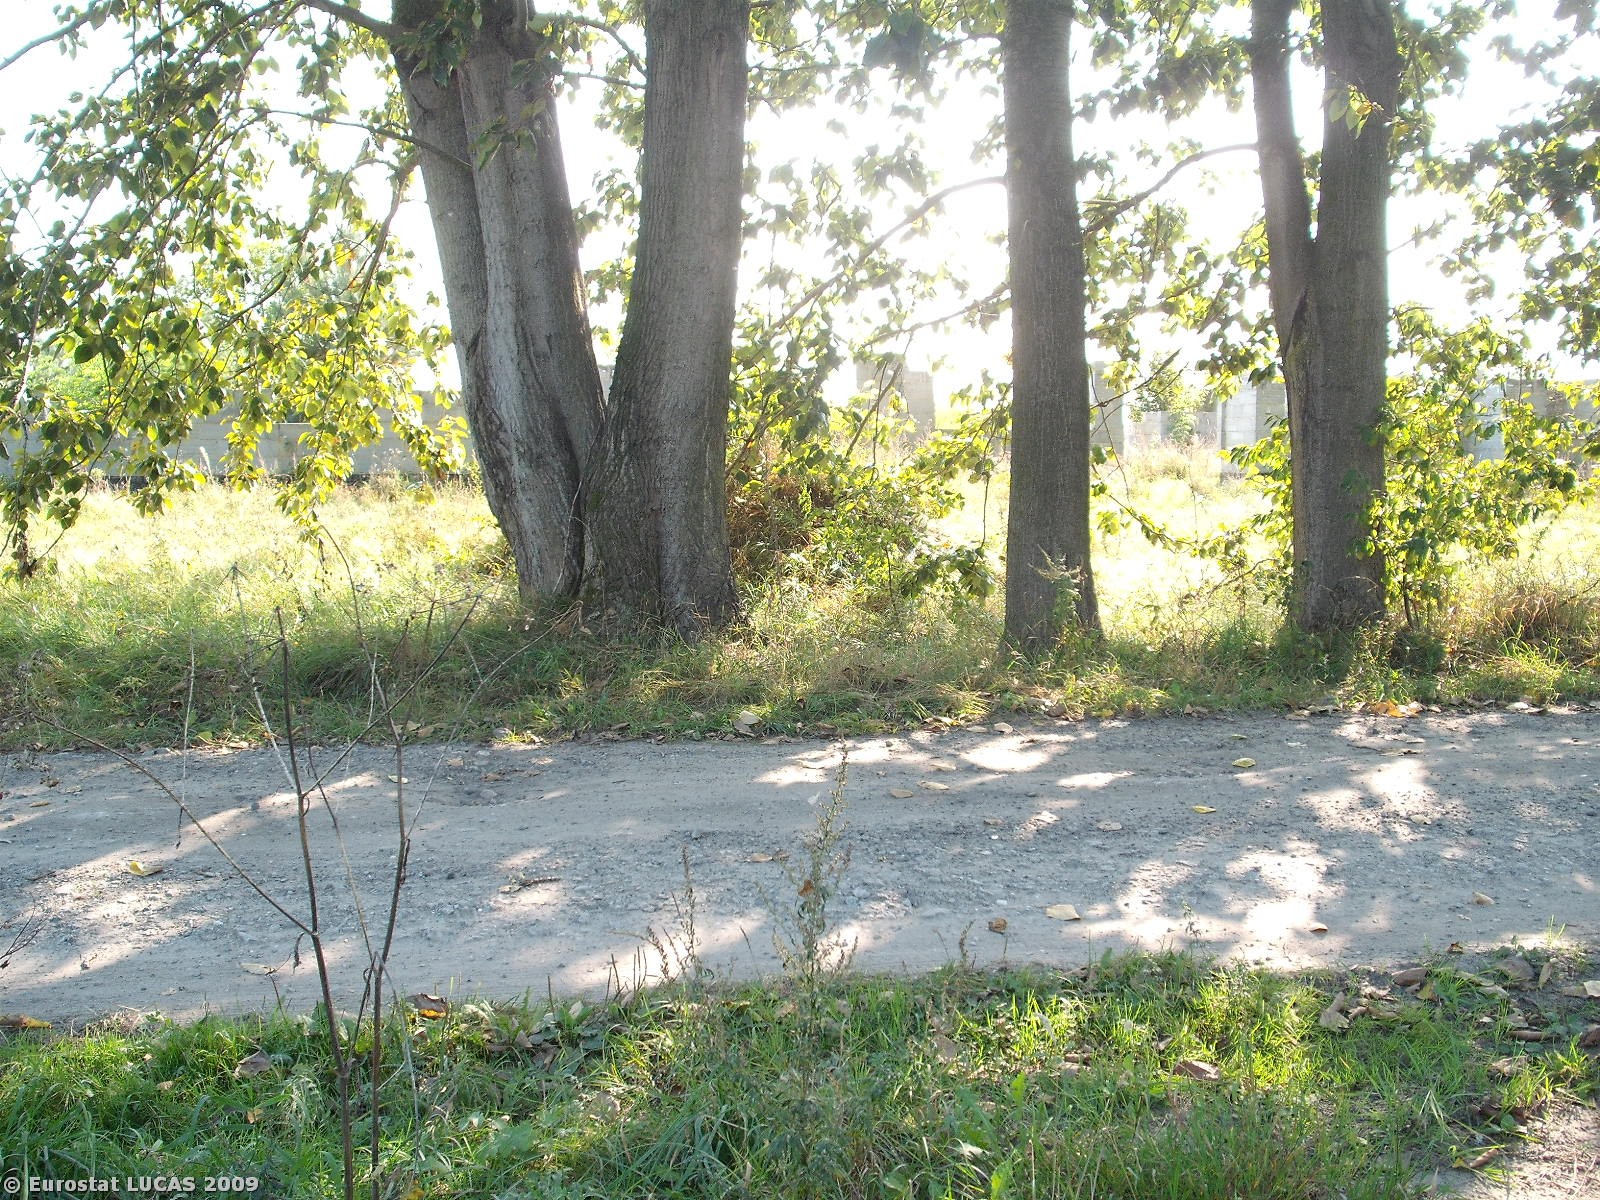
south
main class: Grassland
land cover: Spontaneously vegetated surfaces
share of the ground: > 75 %
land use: Unused
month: September
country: PL
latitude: 52.0351
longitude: 20.7261
